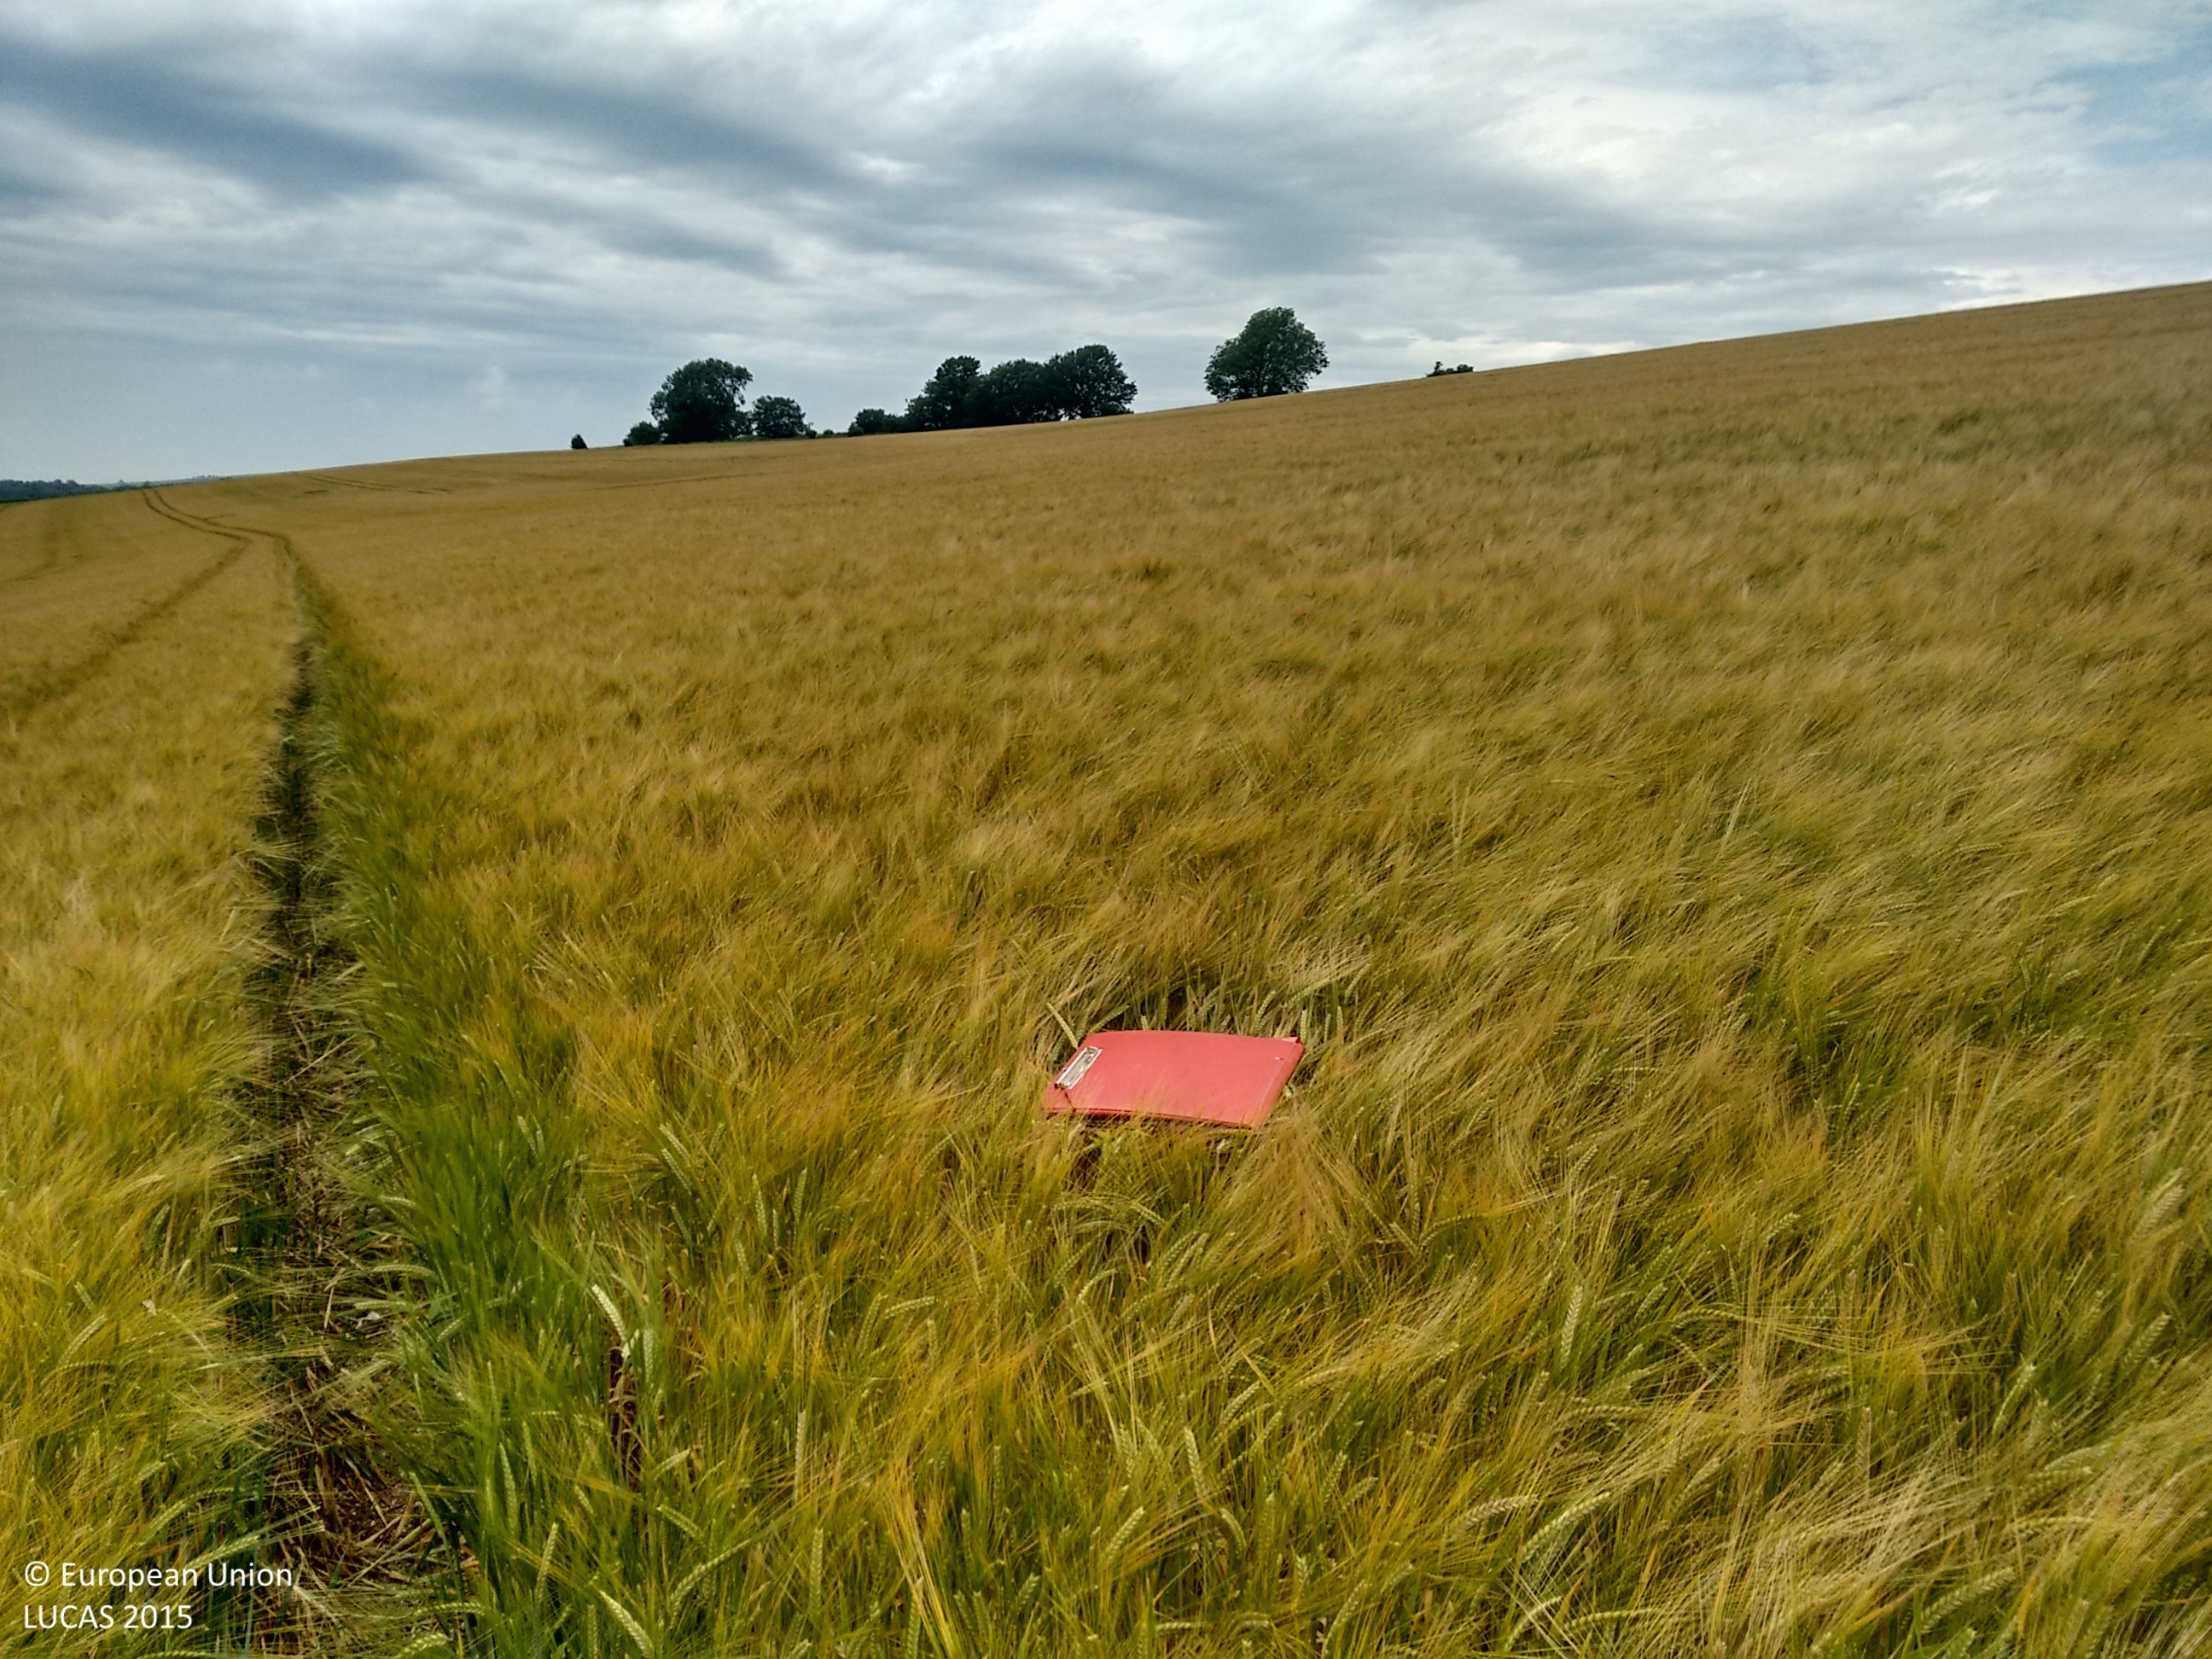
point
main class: Cropland
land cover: Barley
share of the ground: > 75 %
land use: Agriculture (excluding fallow land and kitchen gardens)
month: July
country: GB
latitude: 50.8859
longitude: -0.3997
